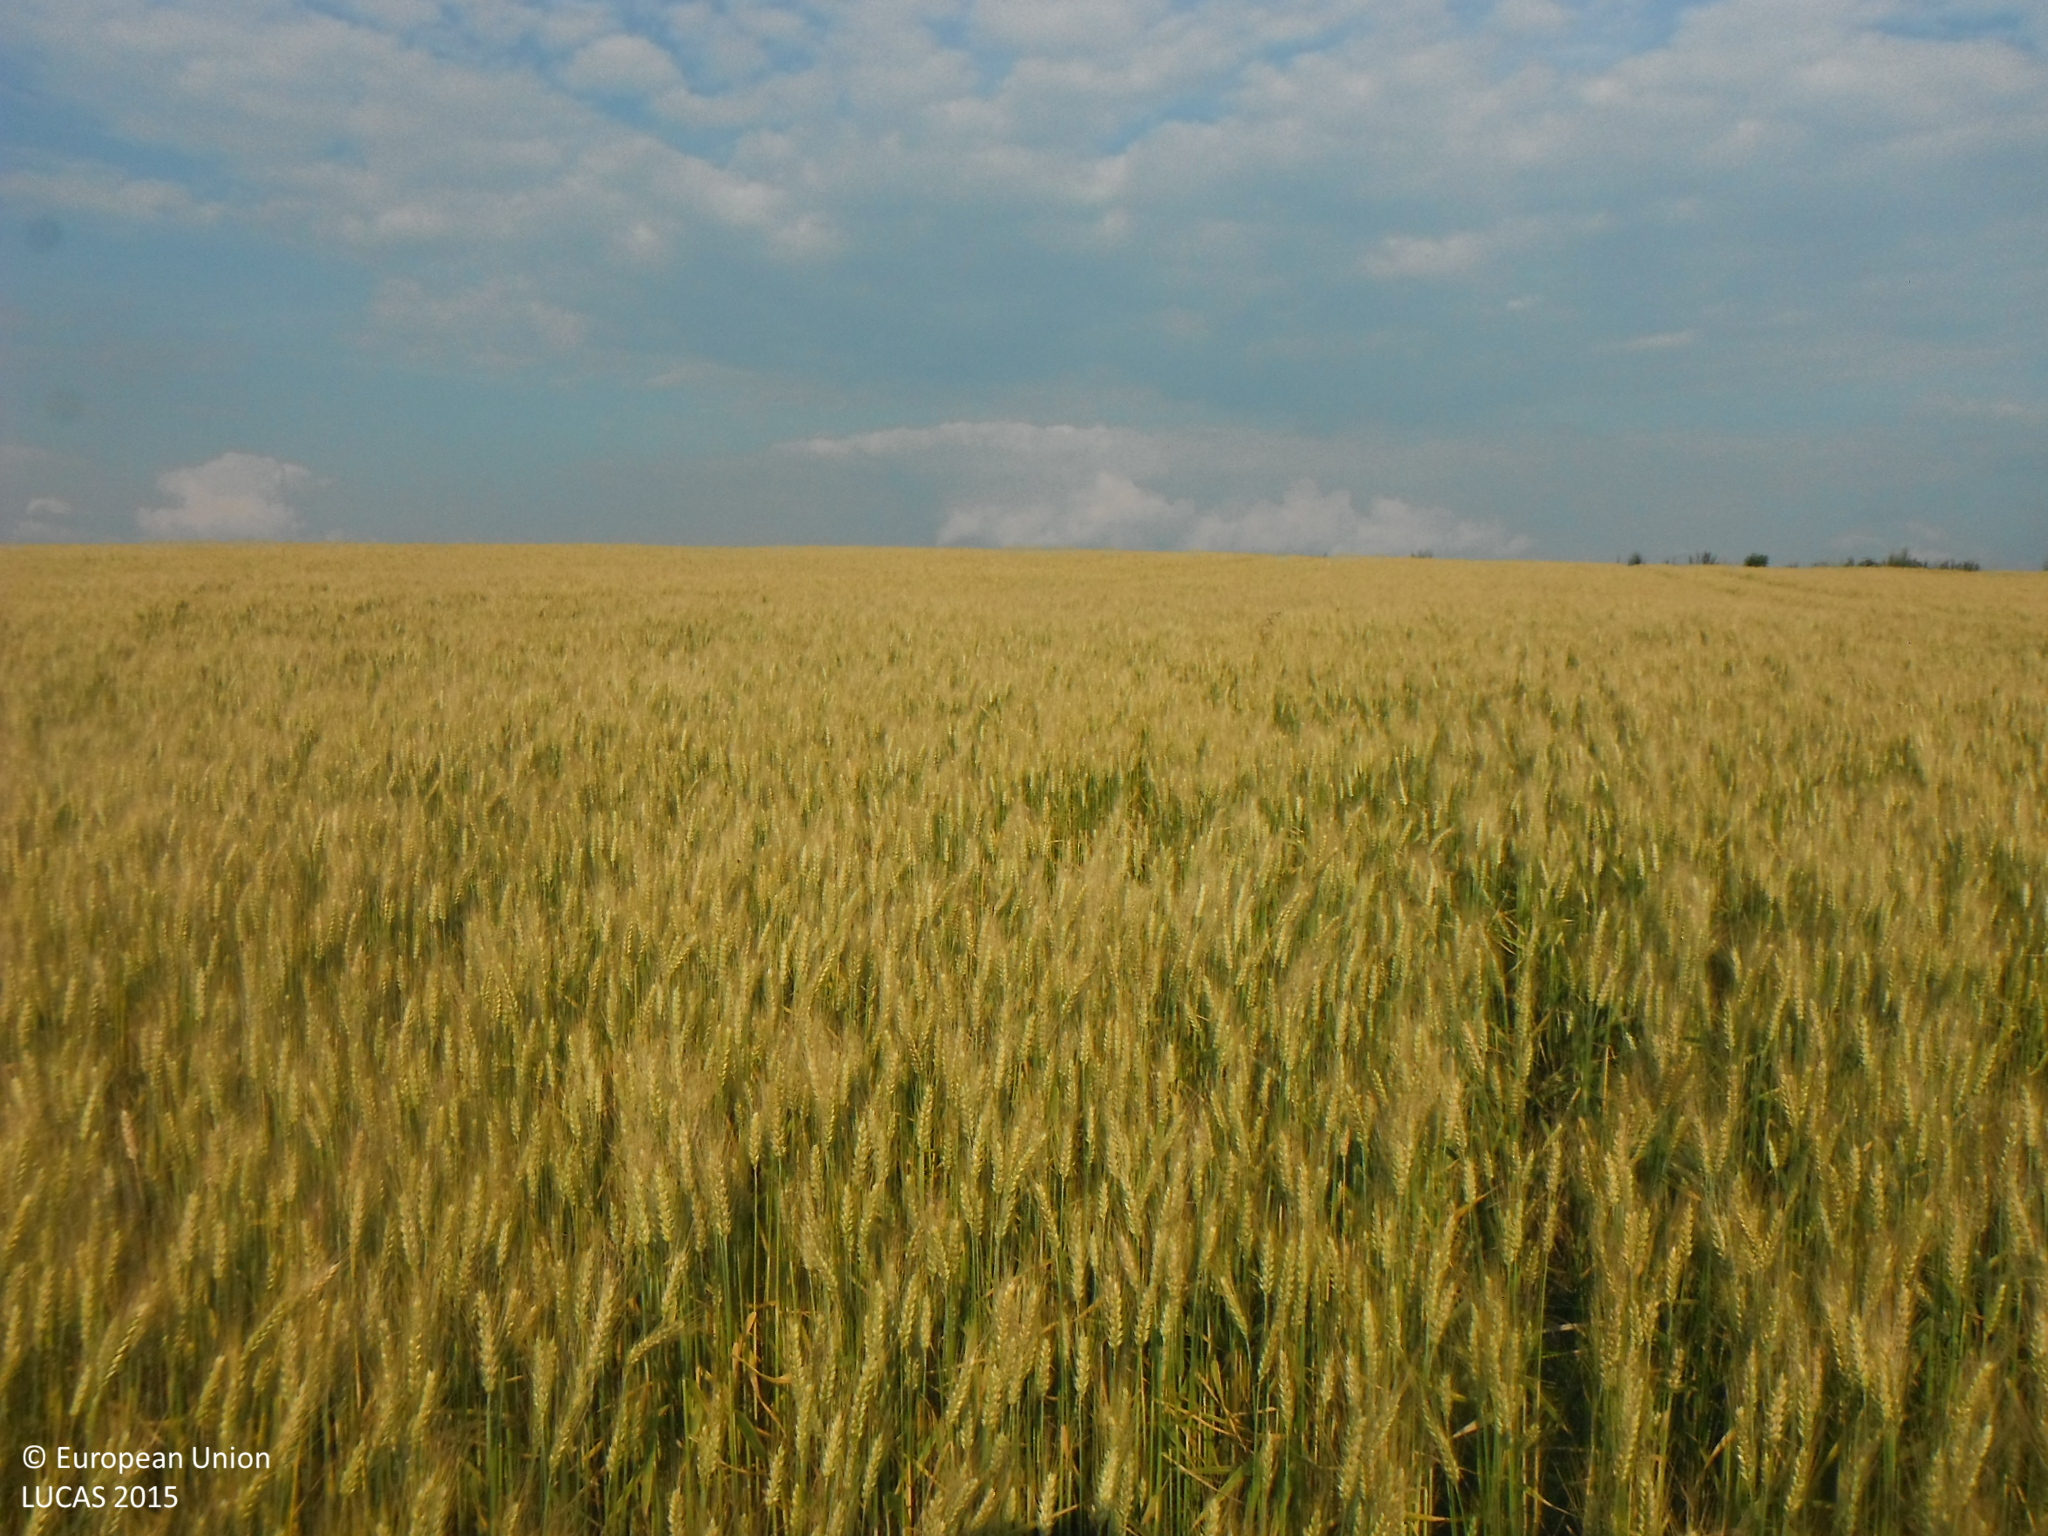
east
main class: Cropland
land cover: Common wheat
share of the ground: > 75 %
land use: Agriculture (excluding fallow land and kitchen gardens)
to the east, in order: Common wheat; Tracks; Barley; Rape and turnip rape
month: July
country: SK
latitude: 49.0030
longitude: 21.8225
